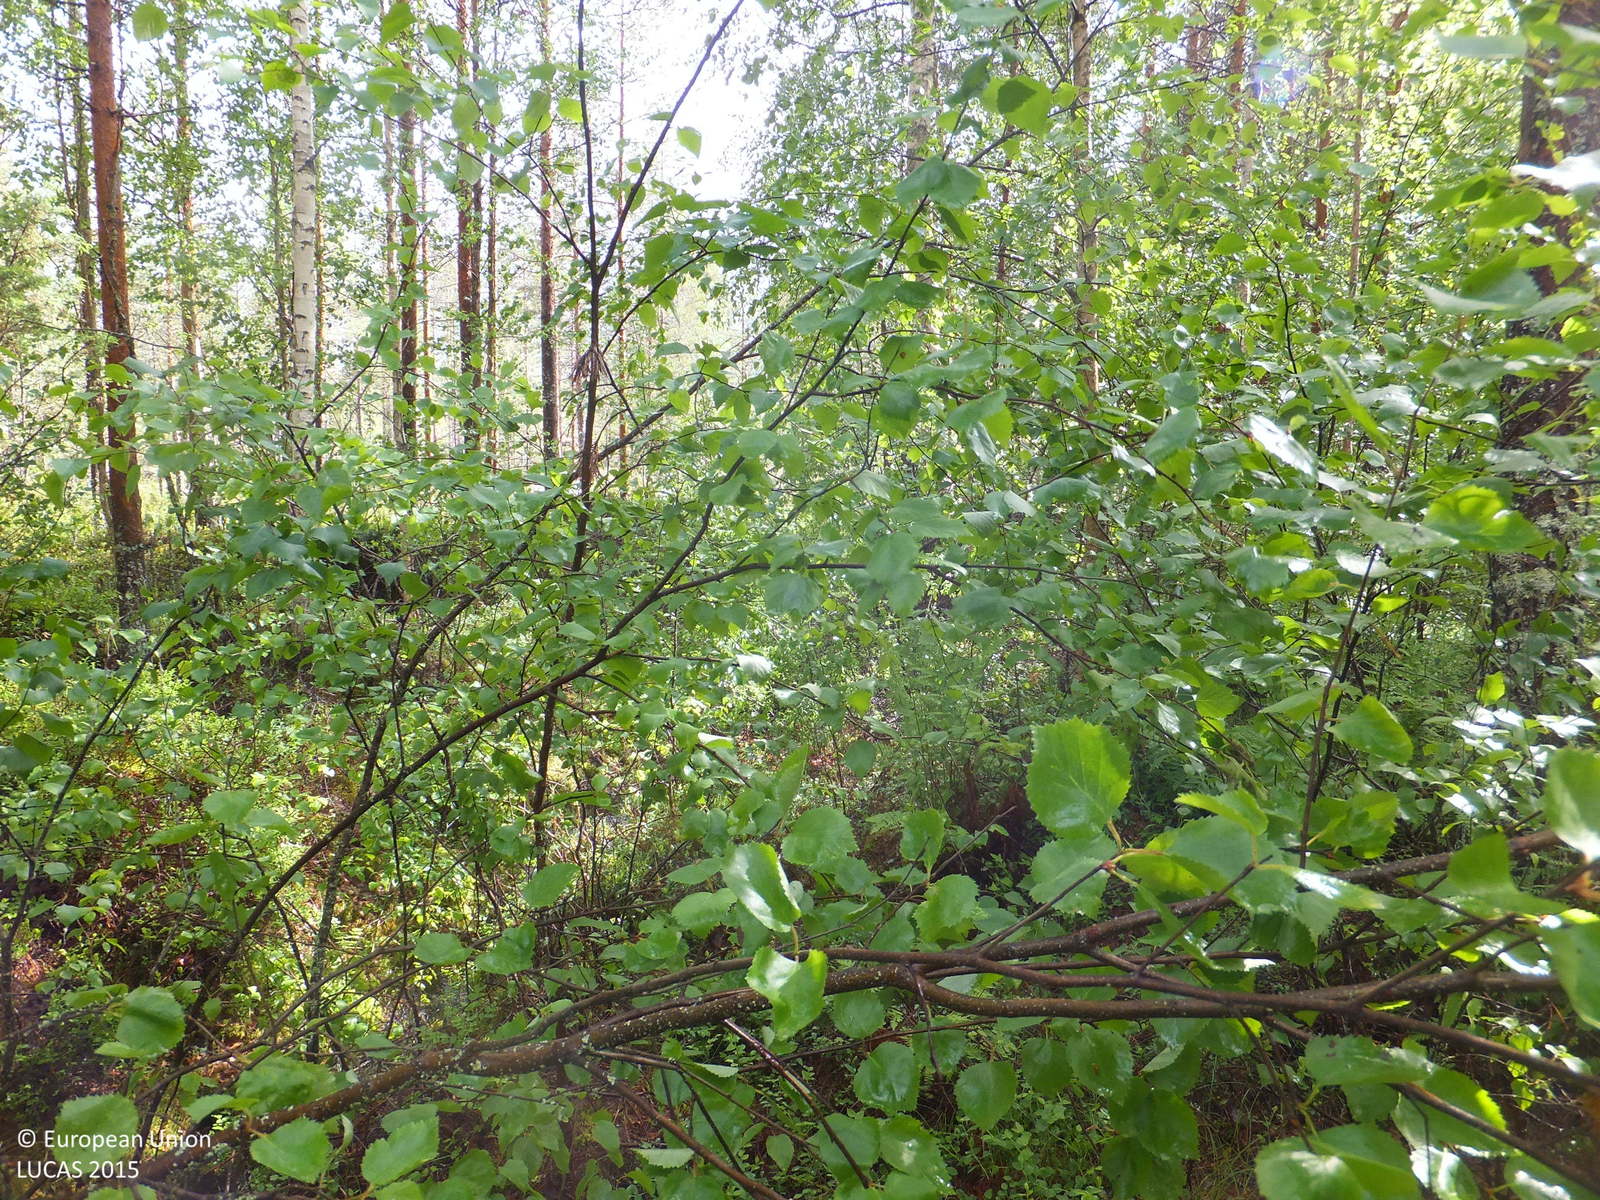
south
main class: Woodland
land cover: Pine dominated mixed woodland
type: boreal forest
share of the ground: > 75 %
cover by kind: coniferous forest trees 45 %, broadleaved forest trees 35 %, herbaceous plants 10 %, shrubs 5 %, lichens and mosses 5 %
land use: Forestry
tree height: > 5 m
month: June
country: FI
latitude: 63.4212
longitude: 24.8111
